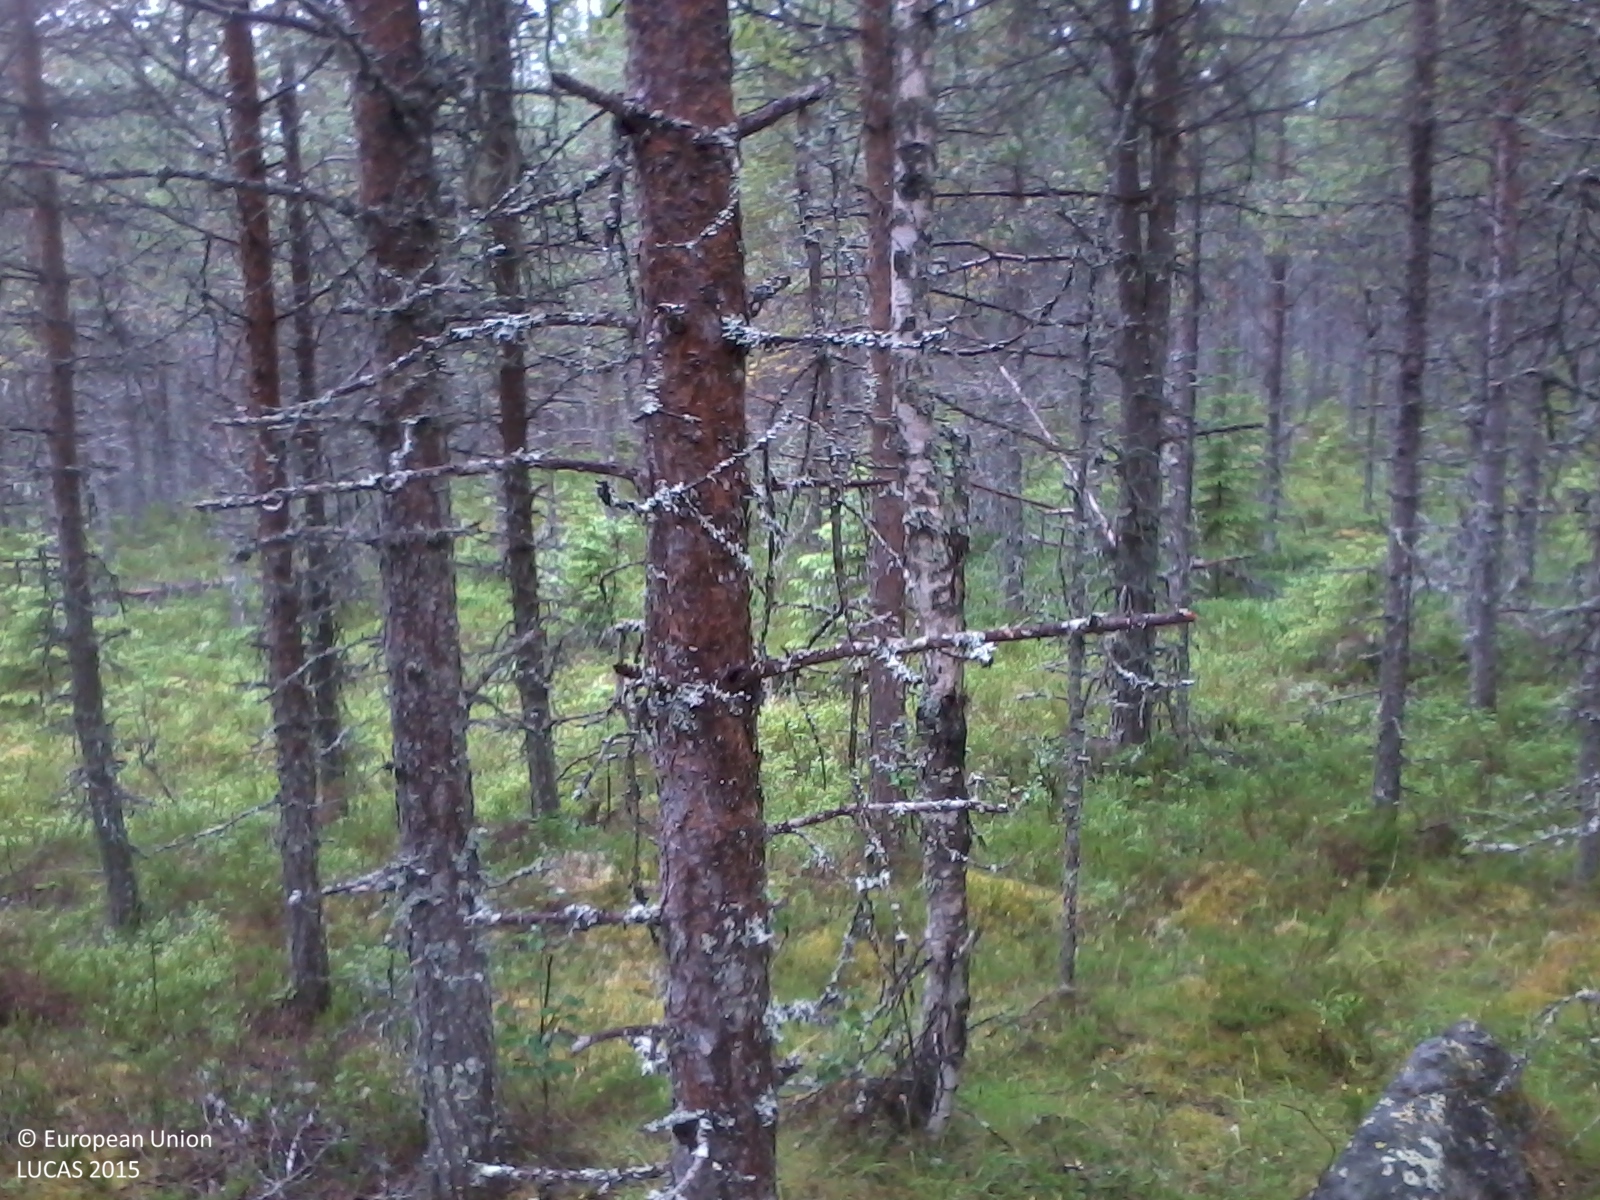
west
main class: Woodland
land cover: Pine dominated coniferous woodland
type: boreal forest
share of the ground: > 75 %
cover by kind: coniferous forest trees 75 %, lichens and mosses 15 %, shrubs 10 %
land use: Forestry
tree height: > 5 m
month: August
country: SE
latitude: 62.8879
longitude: 16.9201
